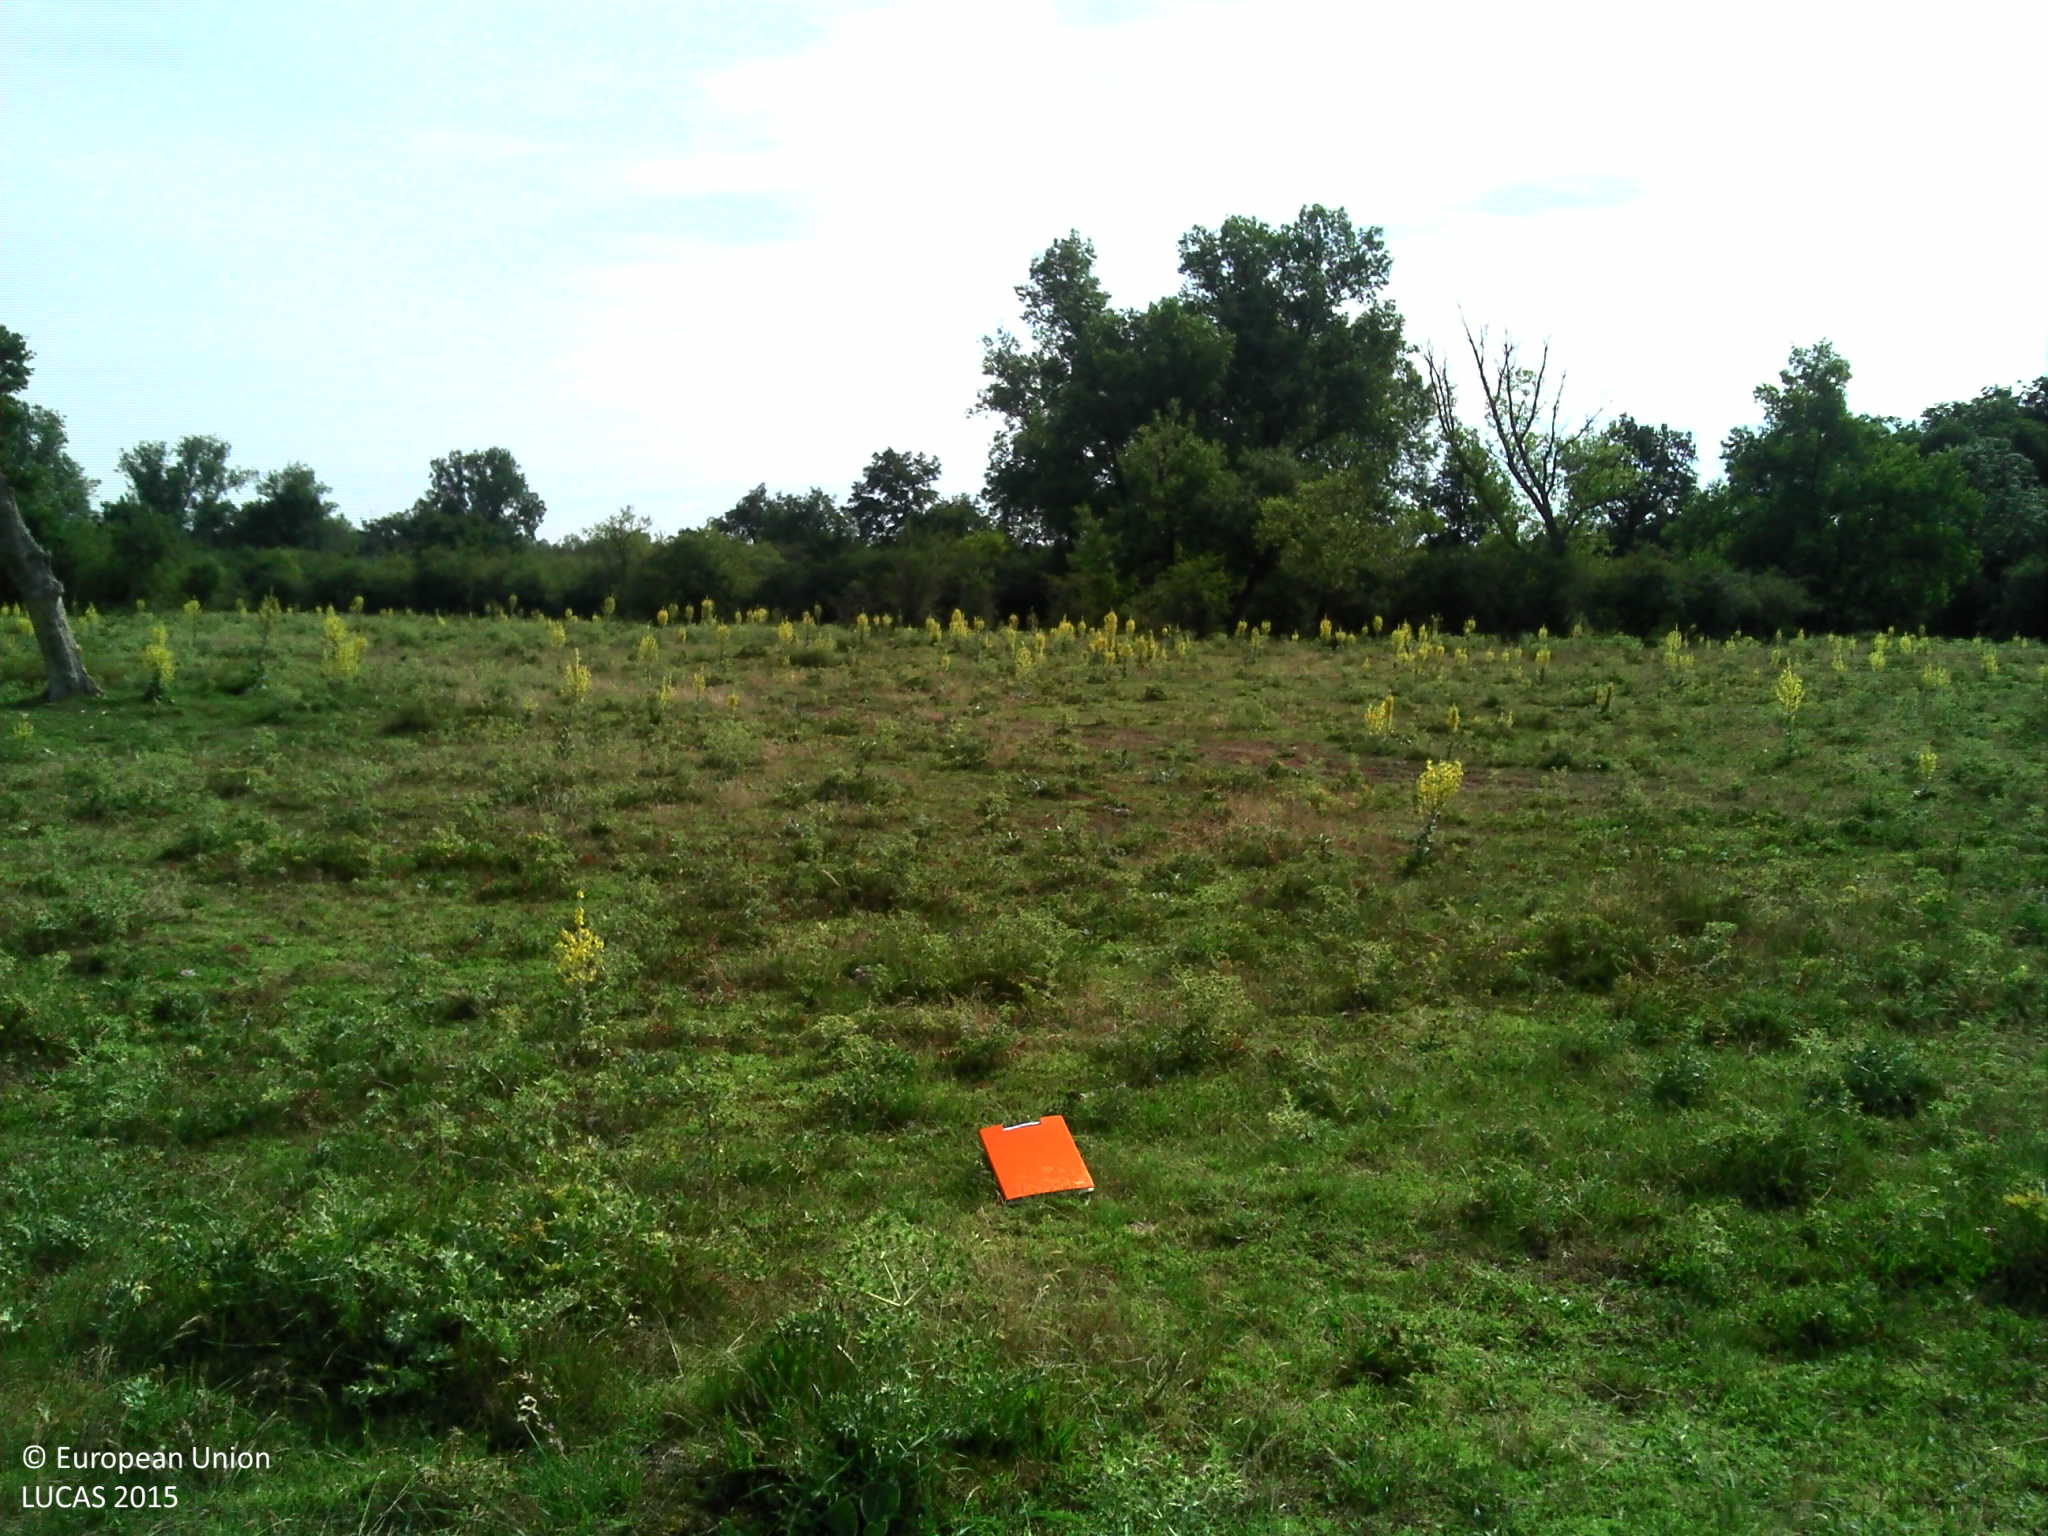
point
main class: Grassland
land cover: Grassland without tree/shrub cover
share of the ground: > 75 %
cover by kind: herbaceous plants 95 %, shrubs 5 %
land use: Agriculture (excluding fallow land and kitchen gardens)
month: June
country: FR
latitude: 46.3599
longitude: 3.3313
